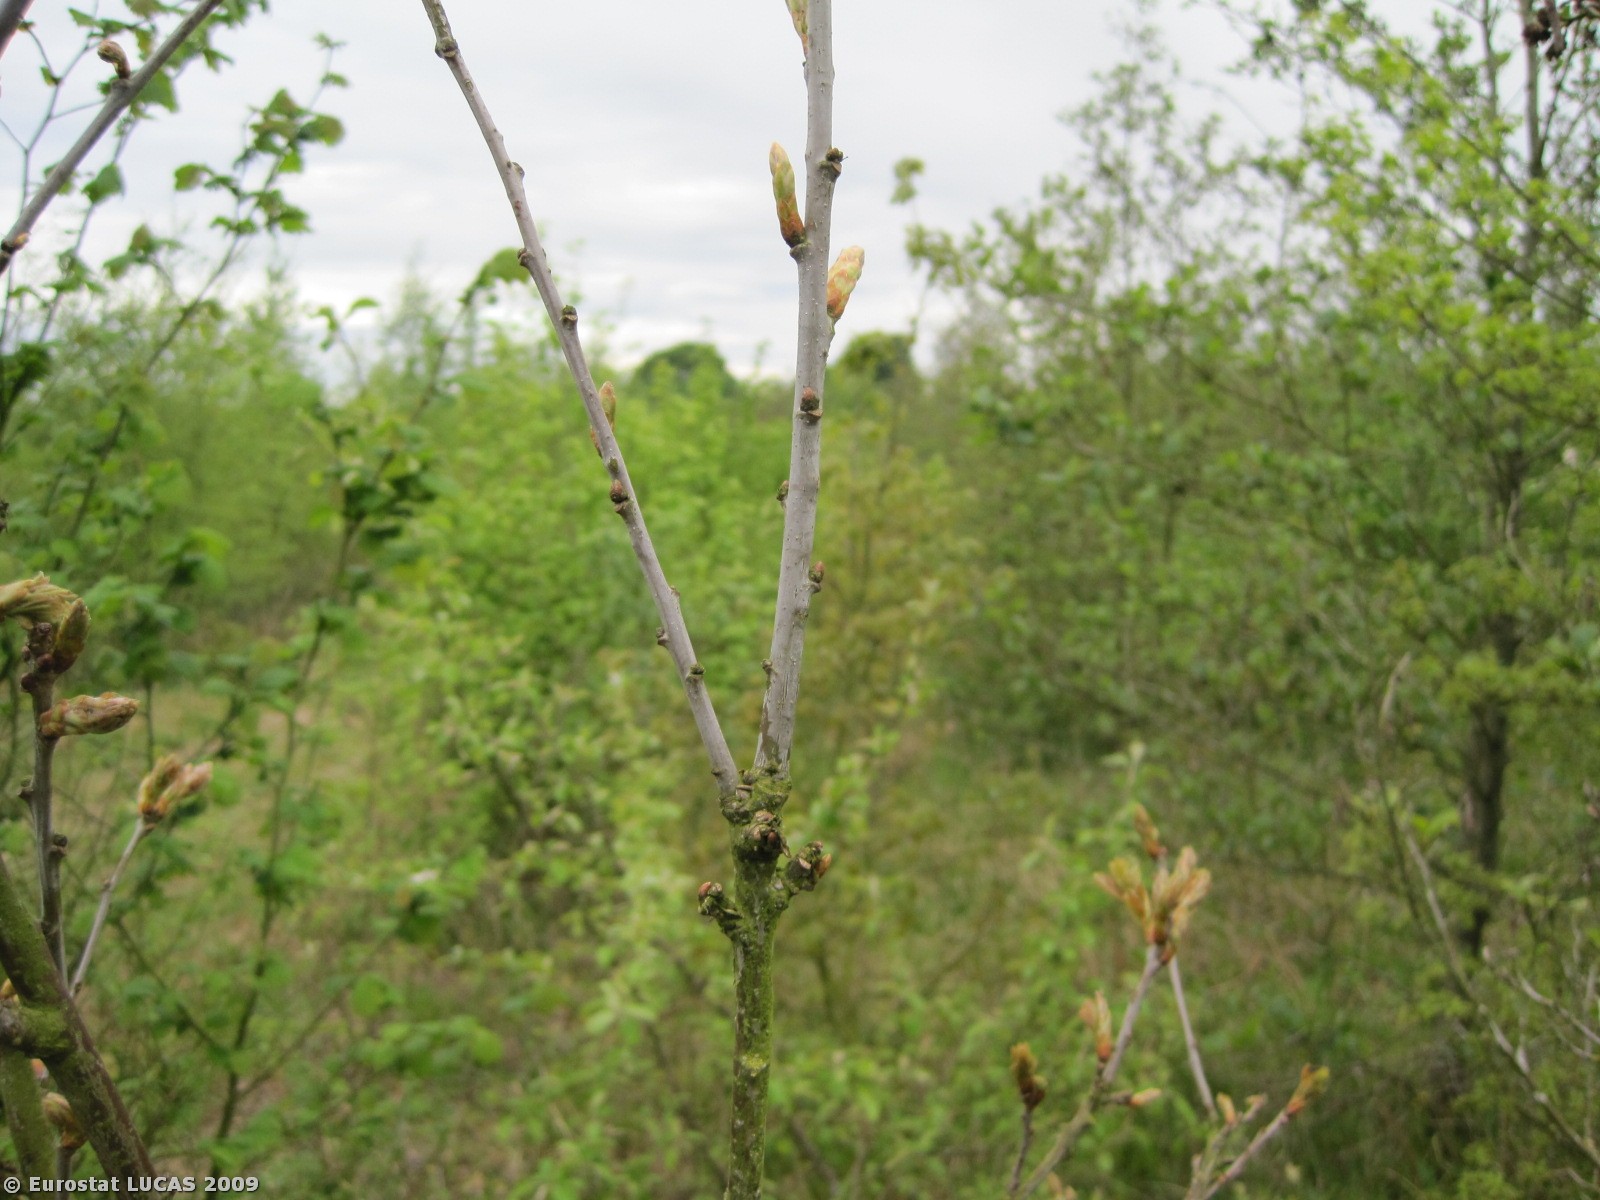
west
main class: Woodland
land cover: Broadleaved woodland
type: plantations and self-sown exotic forest
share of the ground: > 75 %
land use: Forestry
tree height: > 5 m
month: May
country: DK
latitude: 56.7270
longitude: 9.9837
